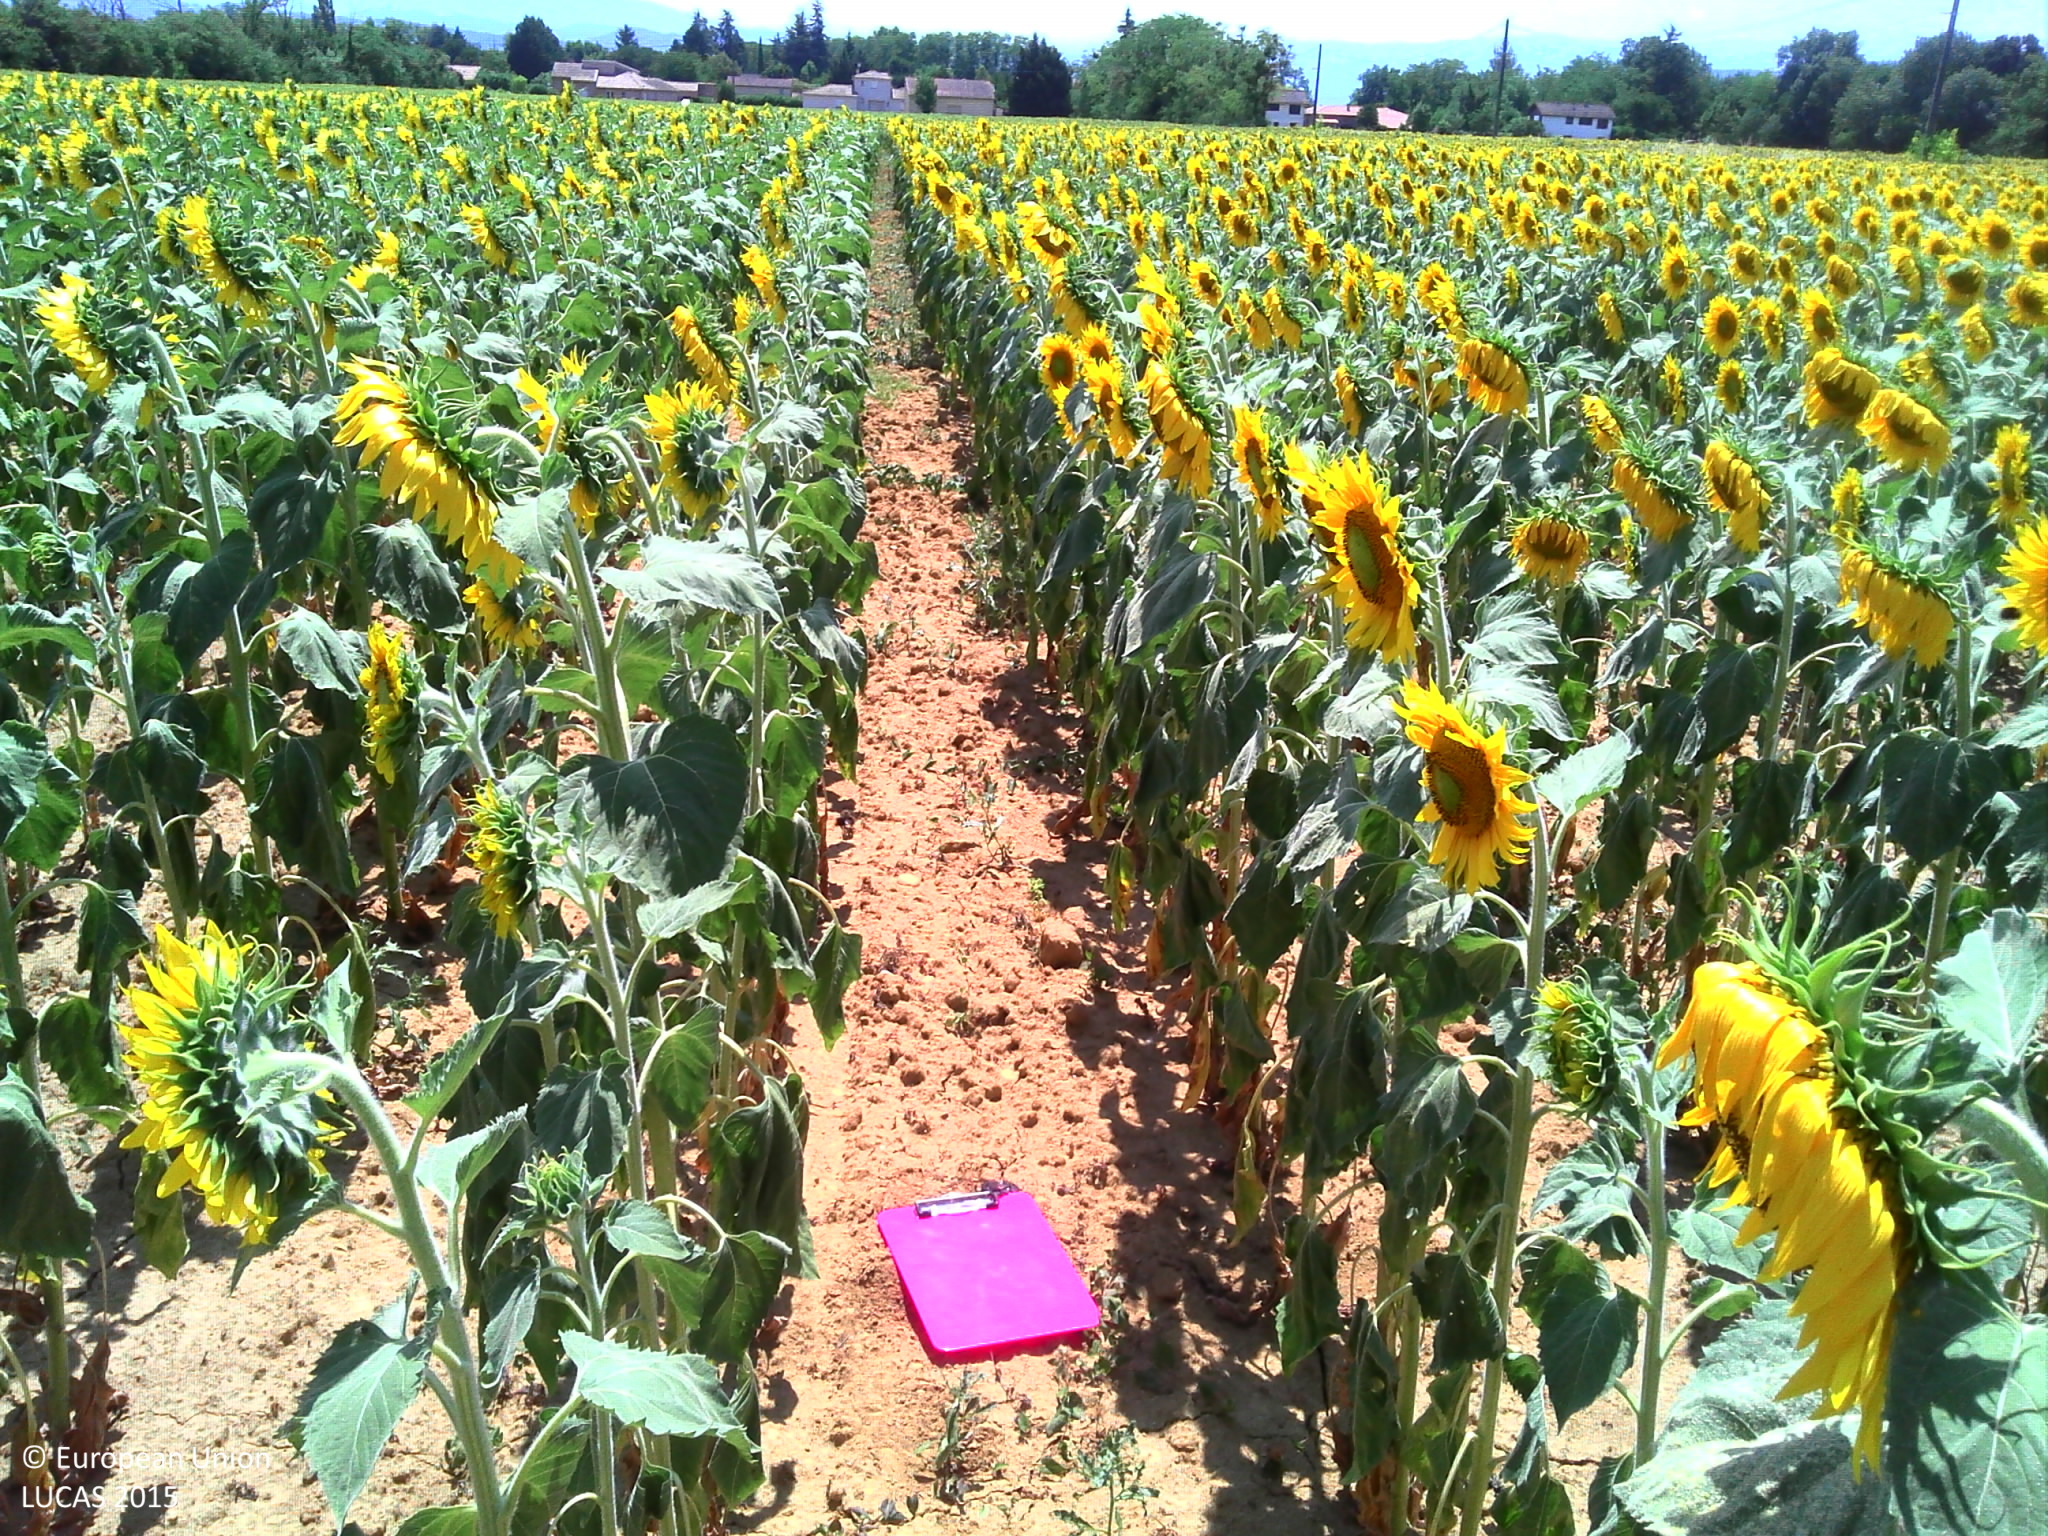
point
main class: Cropland
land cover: Sunflower
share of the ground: 50 - 75 %
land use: Agriculture (excluding fallow land and kitchen gardens)
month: July
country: FR
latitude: 43.1061
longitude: 1.6382
